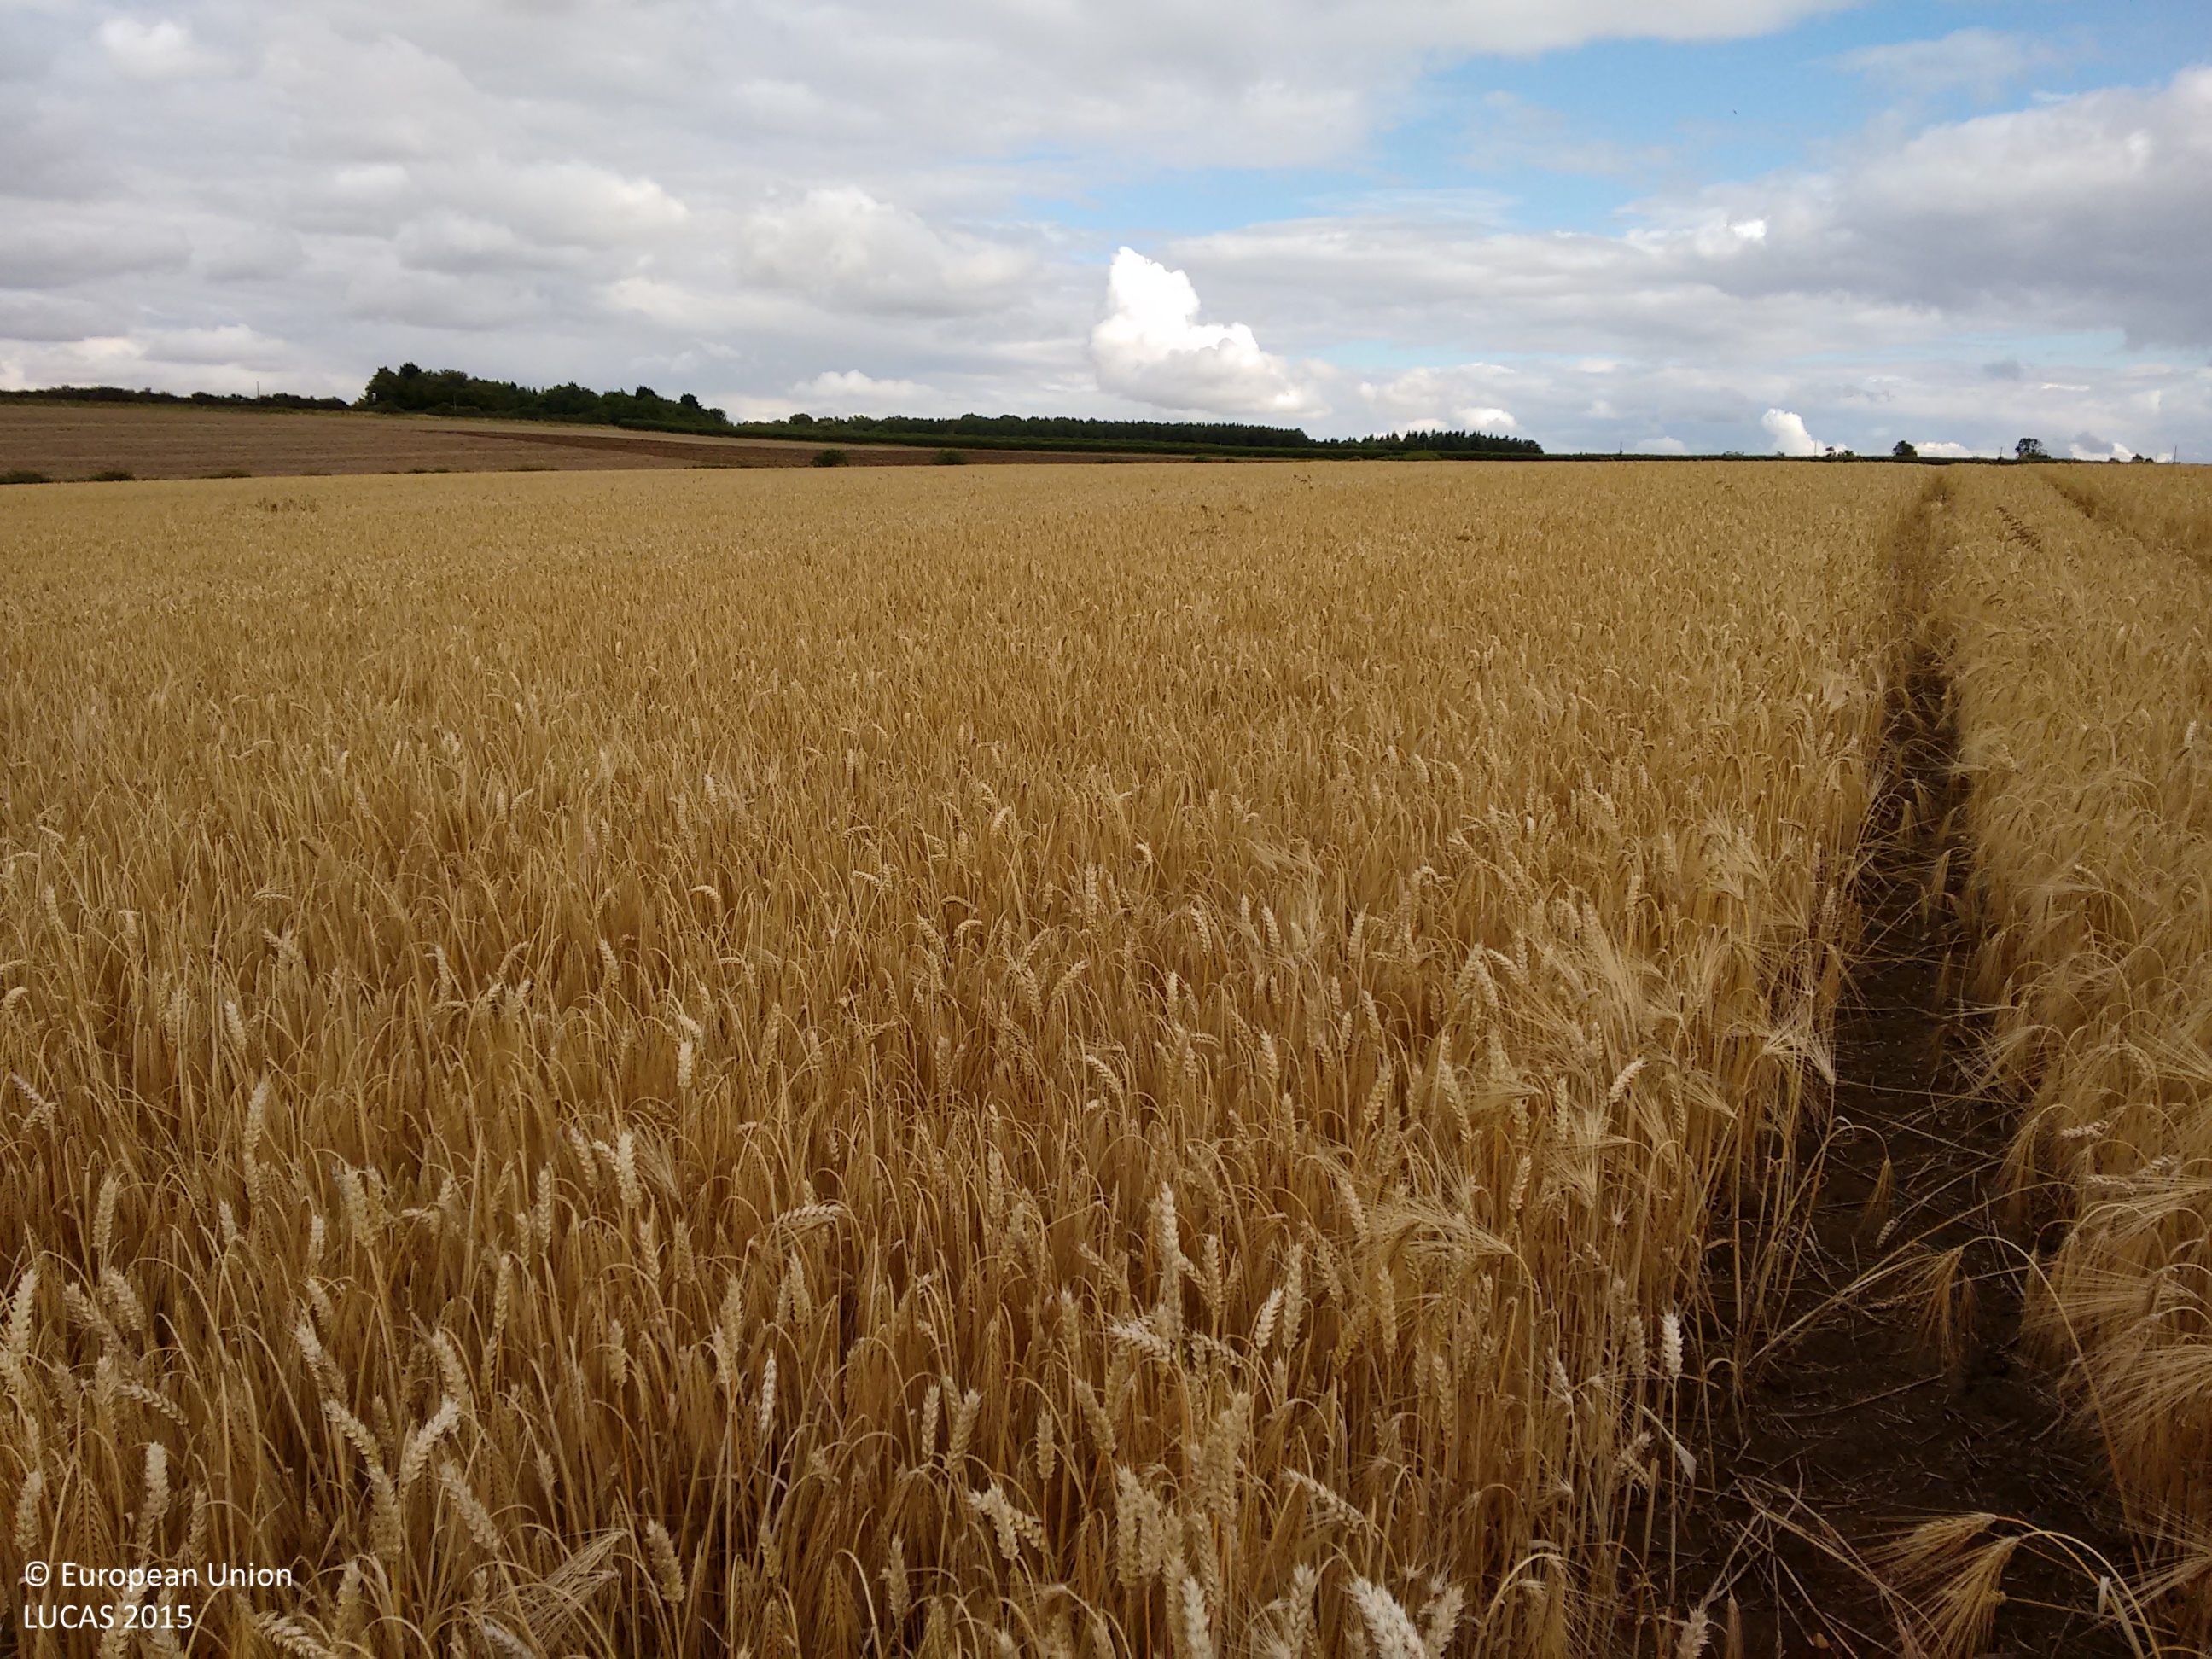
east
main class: Cropland
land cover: Mixed cereals for fodder
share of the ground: > 75 %
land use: Agriculture (excluding fallow land and kitchen gardens)
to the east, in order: Mixed cereals for fodder; Grassland without tree/shrub cover; Ditches and canals; Managed hedges; Grassland without tree/shrub cover; Other bare soil
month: July
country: GB
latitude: 52.7964
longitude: -0.7337
